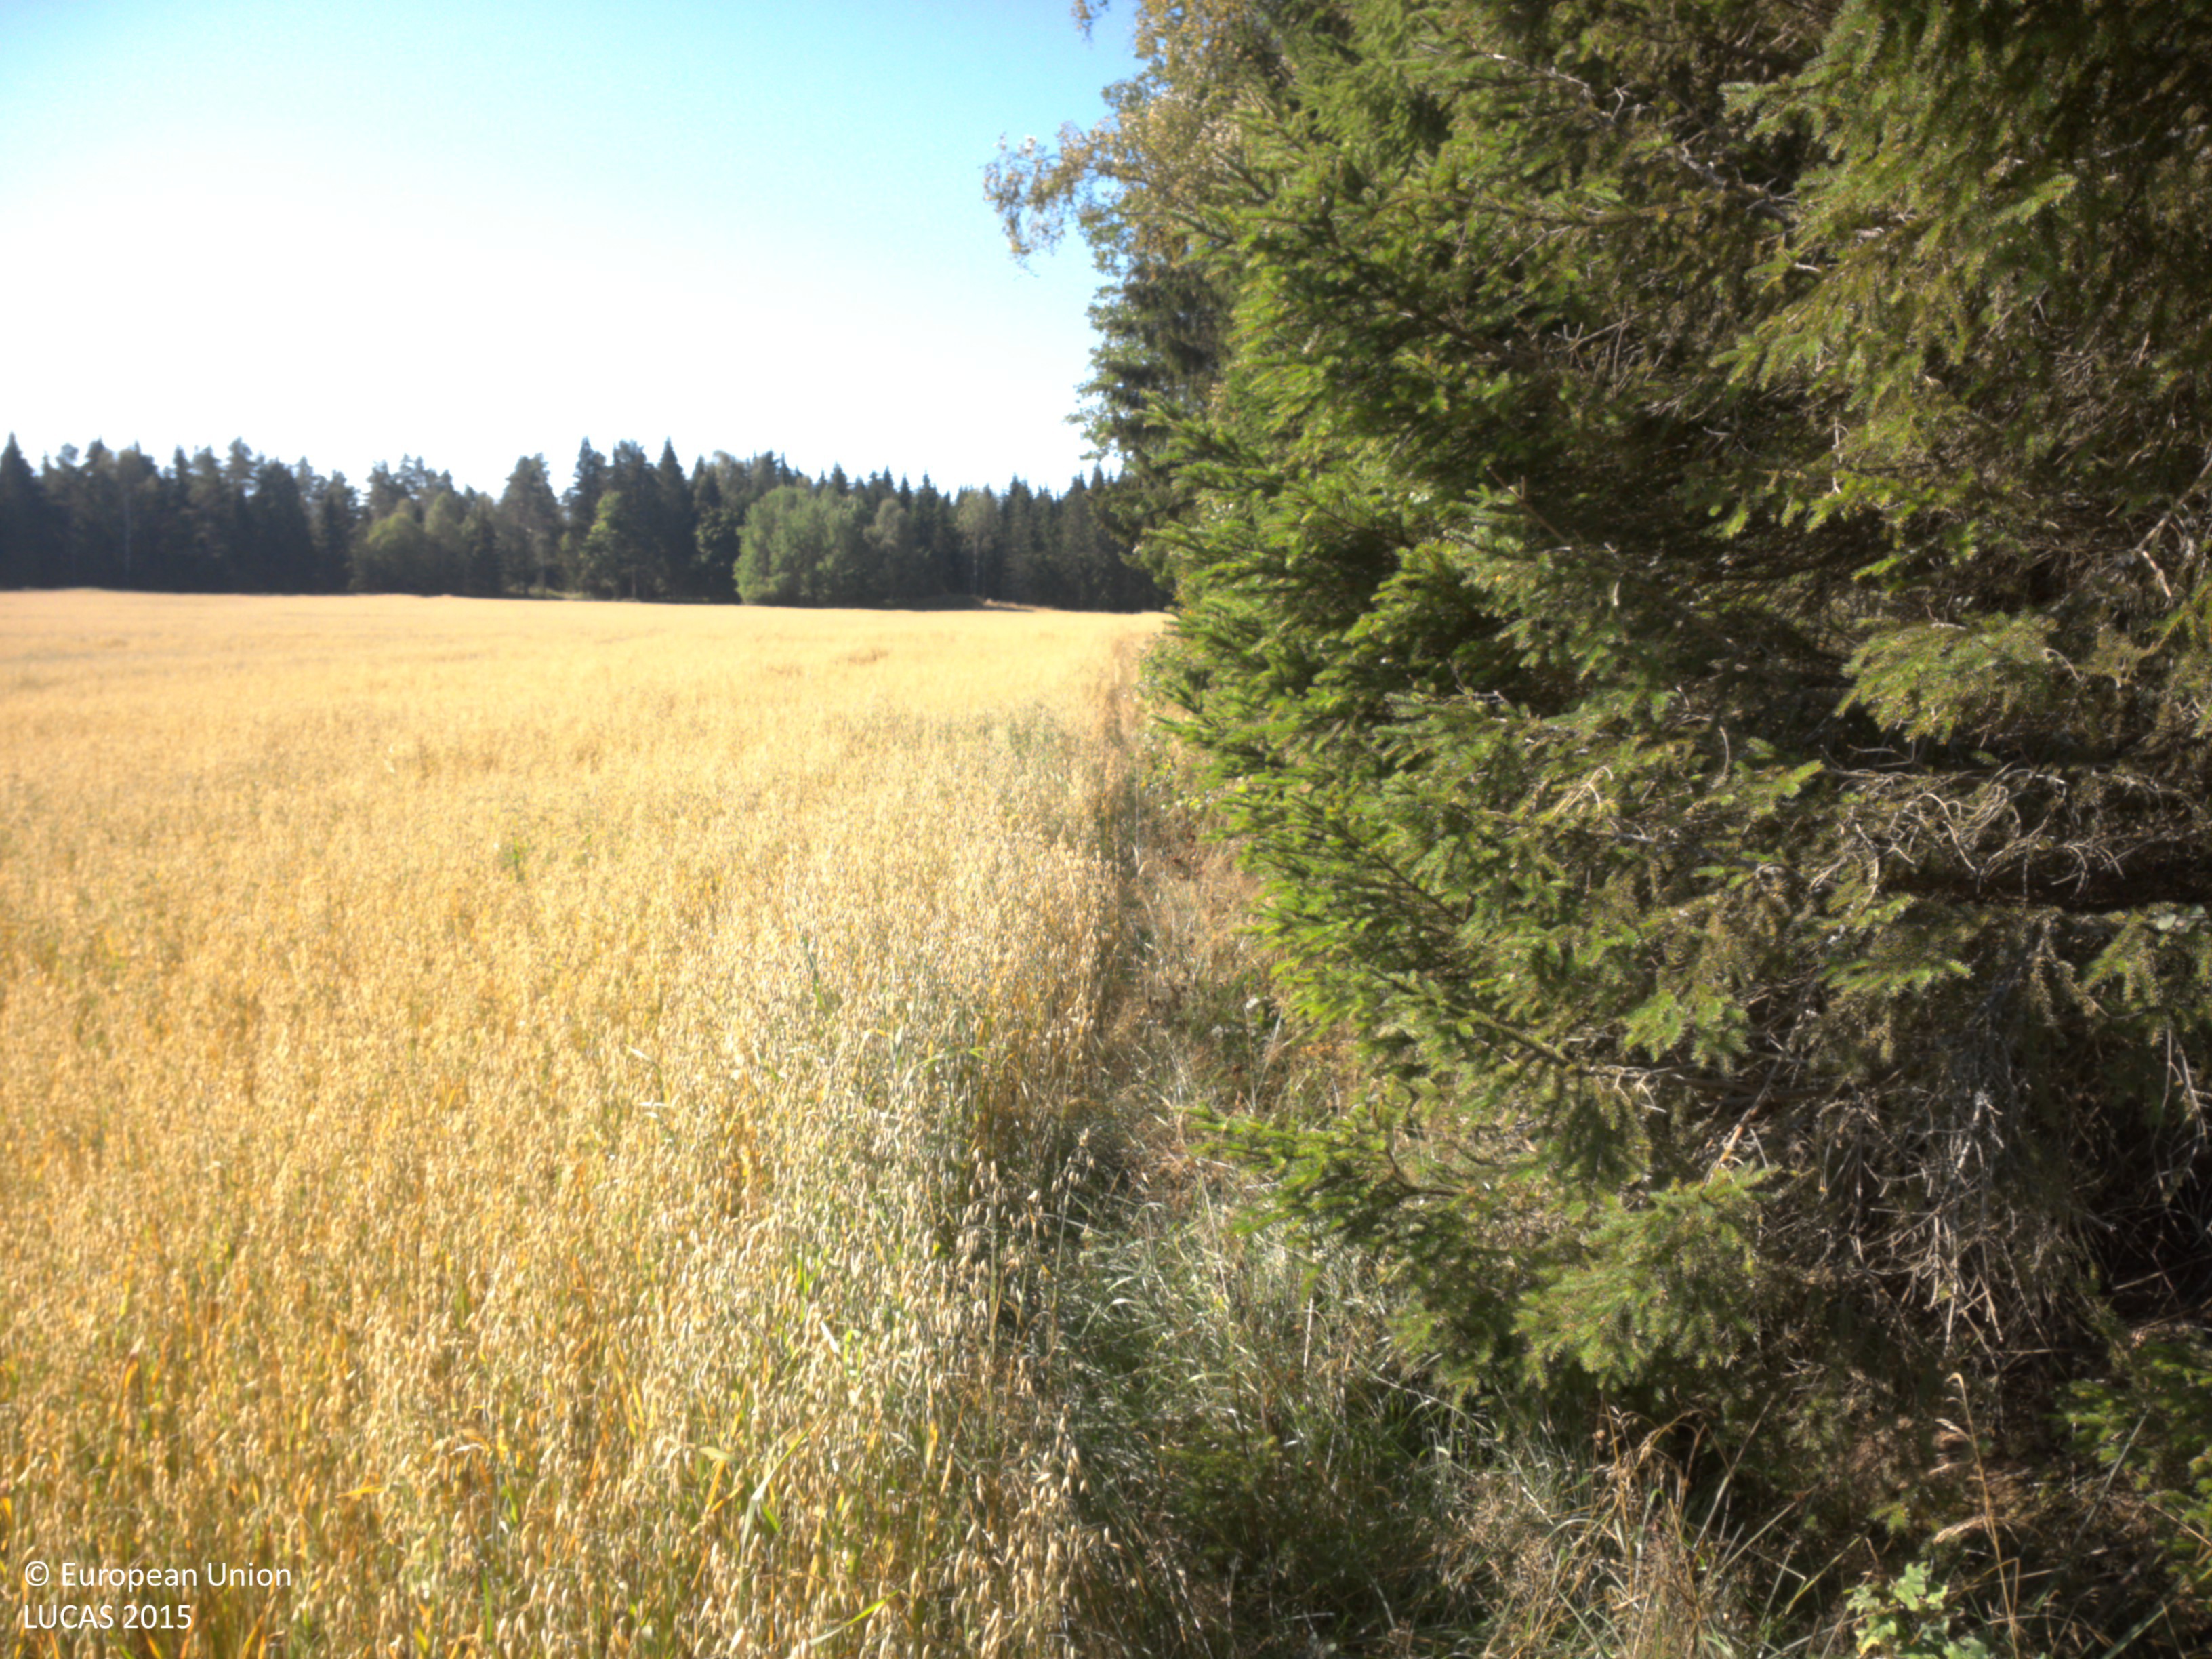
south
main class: Cropland
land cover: Oats
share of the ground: > 75 %
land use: Agriculture (excluding fallow land and kitchen gardens)
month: August
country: SE
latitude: 58.6134
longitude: 12.3192
